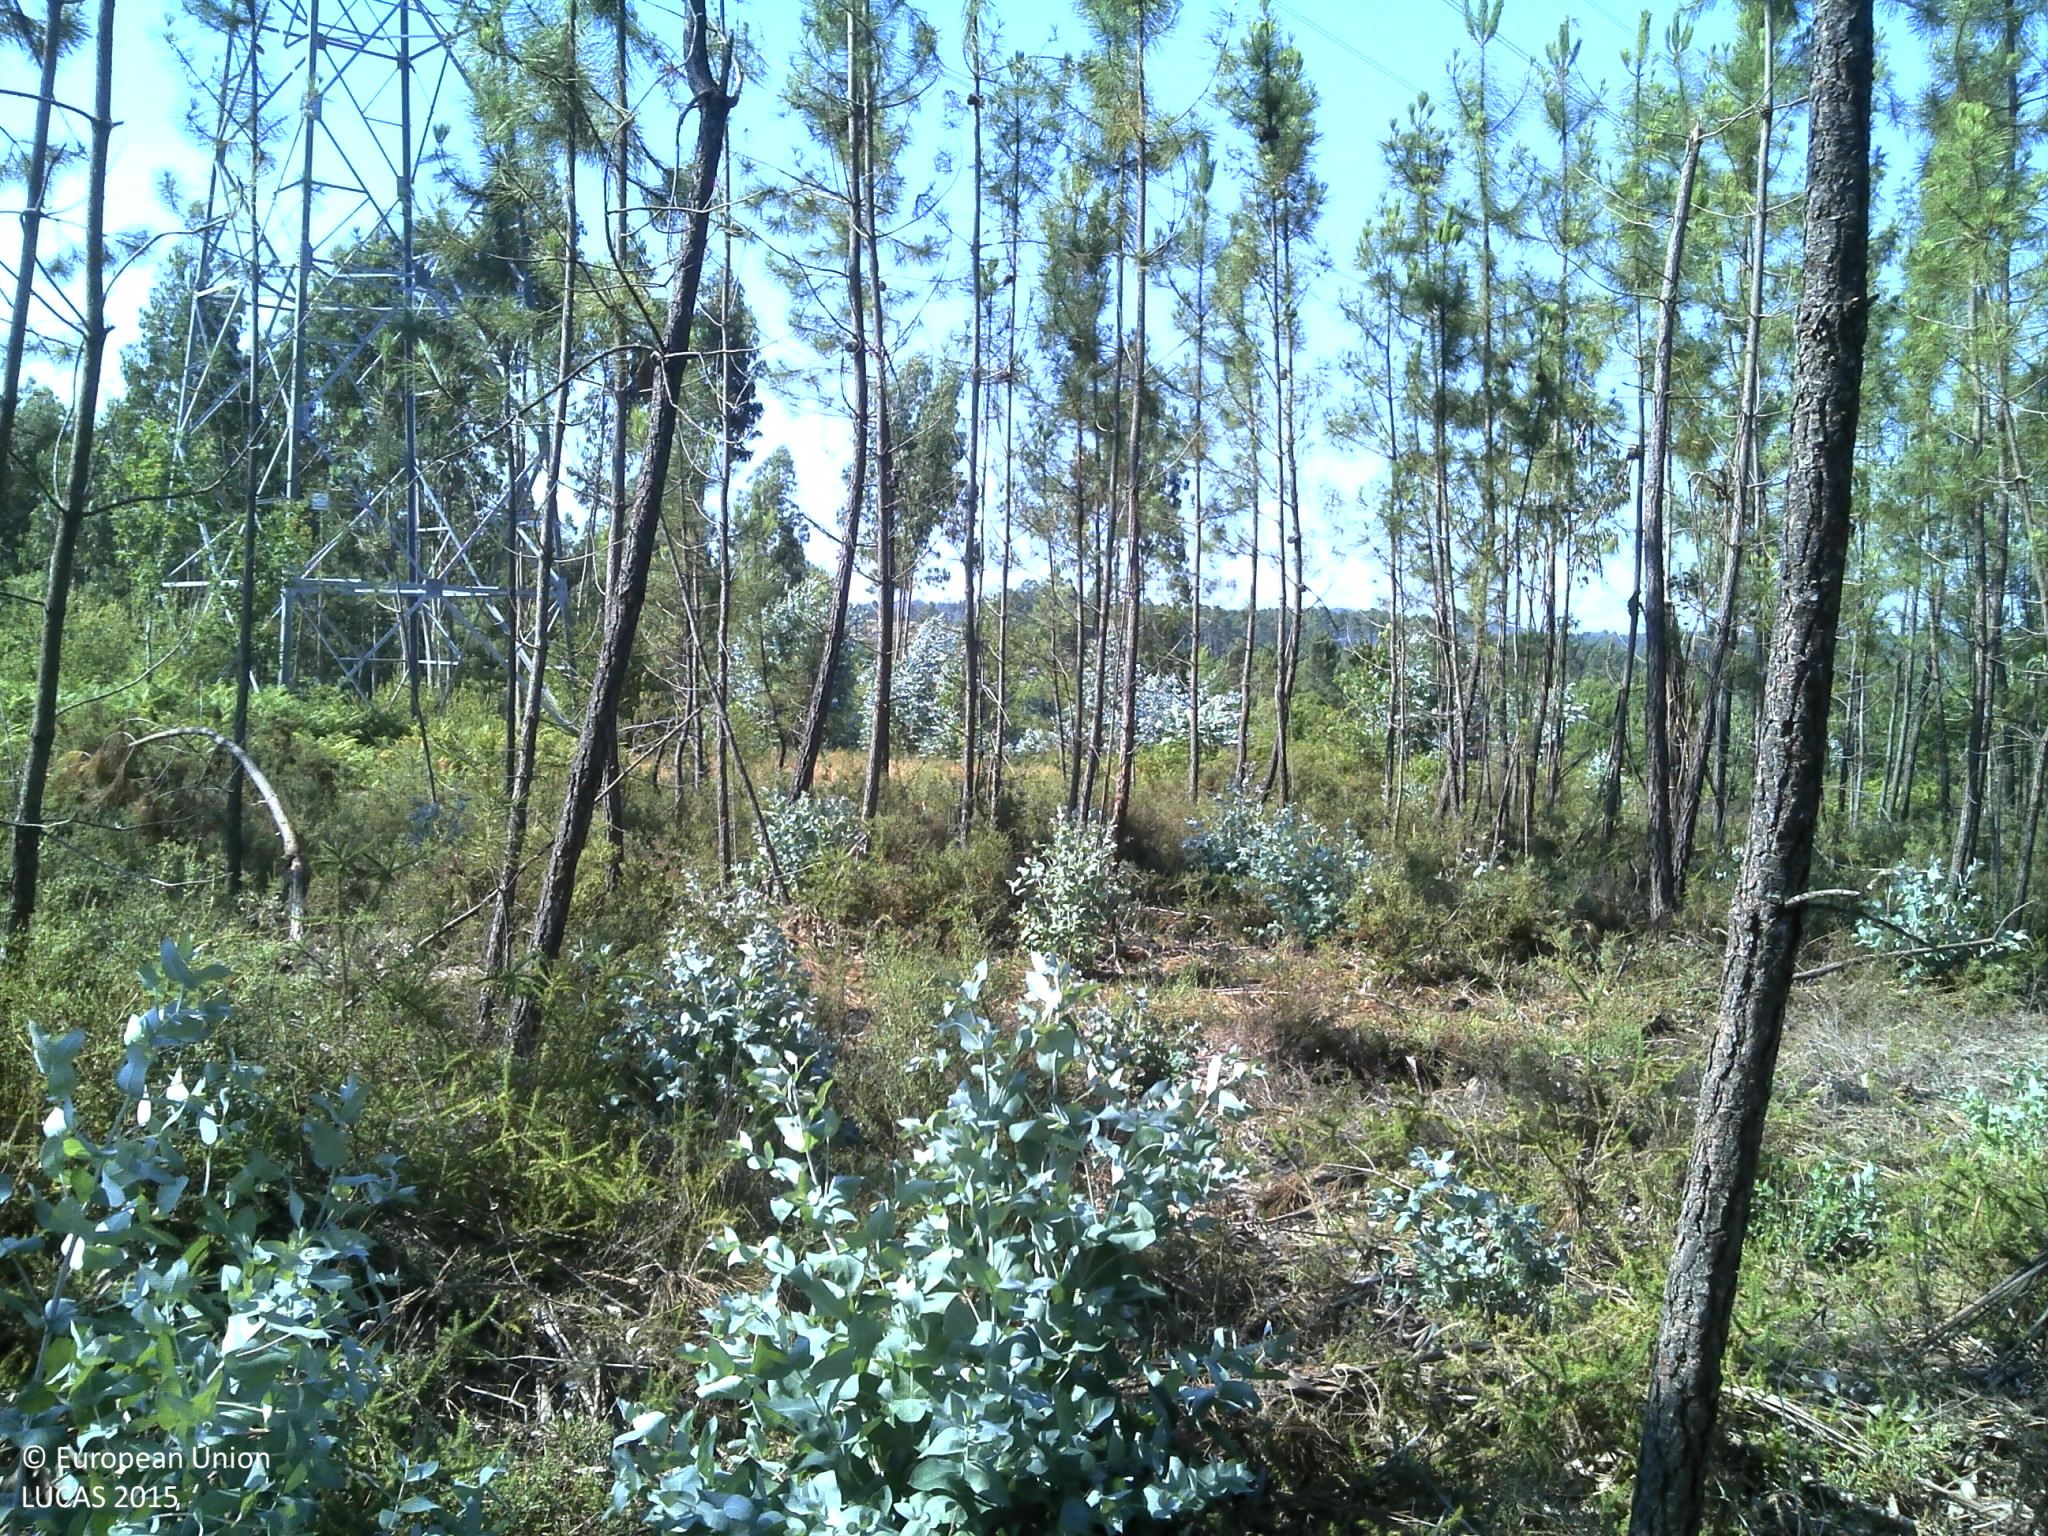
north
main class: Woodland
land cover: Pine dominated coniferous woodland
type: coniferous forest of the mediterranean region
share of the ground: 25 - 50 %
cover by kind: coniferous forest trees 45 %, shrubs 40 %, unconsolidated bare surface 10 %, herbaceous plants 5 %
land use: Forestry
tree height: > 5 m
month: June
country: PT
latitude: 40.6307
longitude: -8.0388
